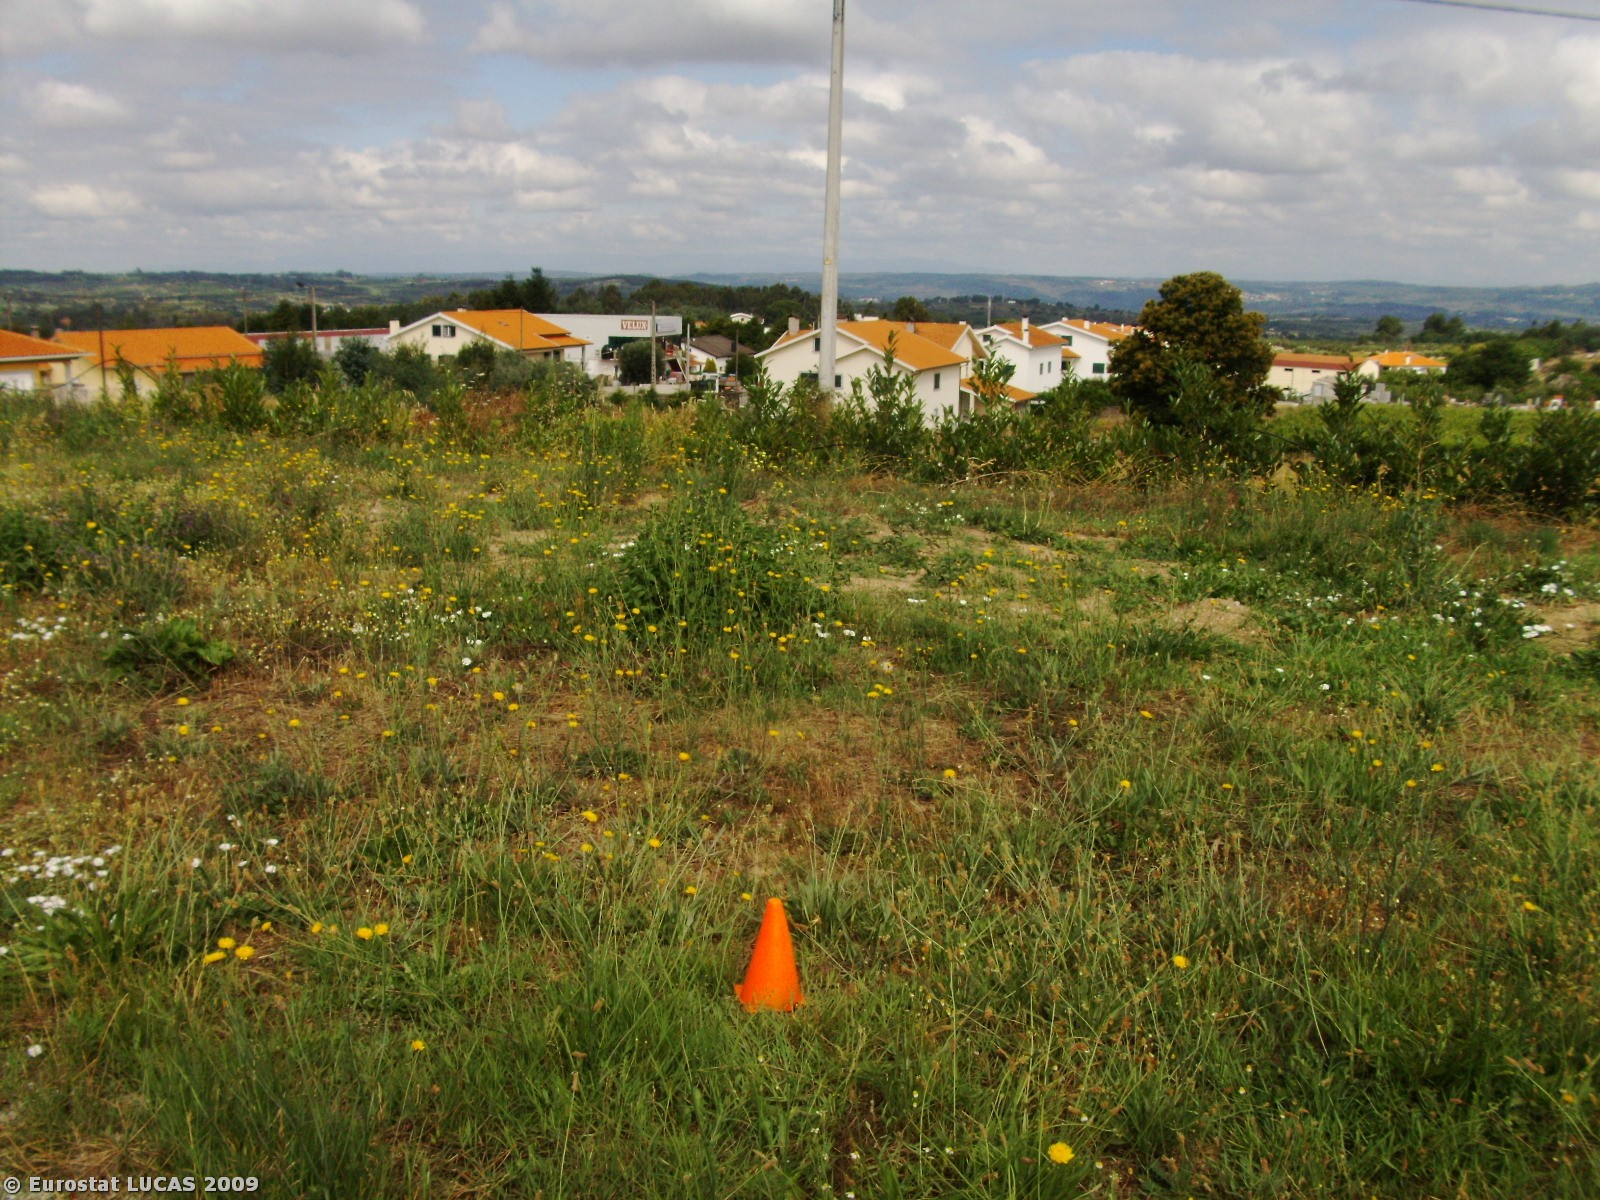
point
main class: Grassland
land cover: Spontaneously vegetated surfaces
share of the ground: > 75 %
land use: Fallow land
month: July
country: PT
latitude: 40.5055
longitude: -7.6145
